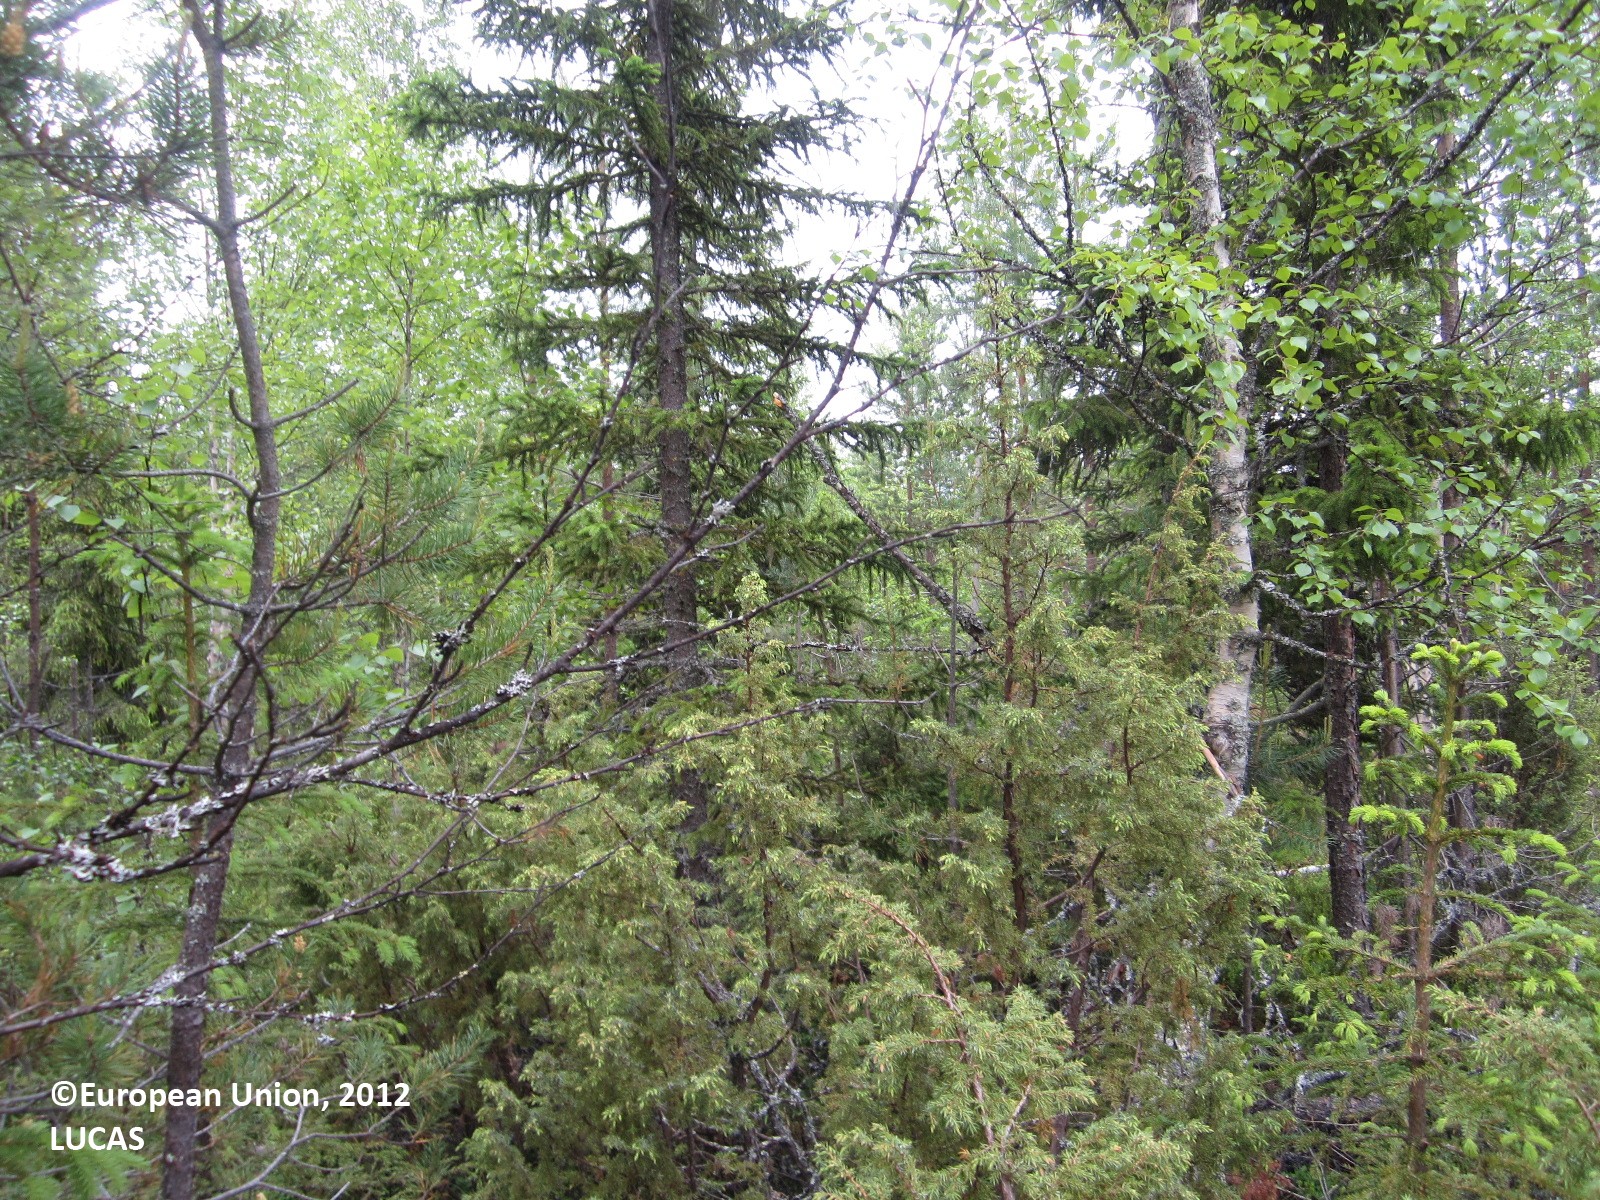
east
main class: Woodland
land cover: Pine dominated mixed woodland
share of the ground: 50 - 75 %
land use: Forestry
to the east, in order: Pine dominated mixed woodland; Ditches and canals; Pine dominated mixed woodland; Ditches and canals; Pine dominated mixed woodland; Ditches and canals; Pine dominated mixed woodland; Ditches and canals; Pine dominated mixed woodland; Ditches and canals; Pine dominated mixed woodland; Ditches and canals; Pine dominated mixed woodland; Tracks; Pine dominated mixed woodland; Ditches and canals; Pine dominated coniferous woodland; Ditches and canals; Pine dominated coniferous woodland
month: June
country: FI
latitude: 64.6646
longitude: 29.6755
